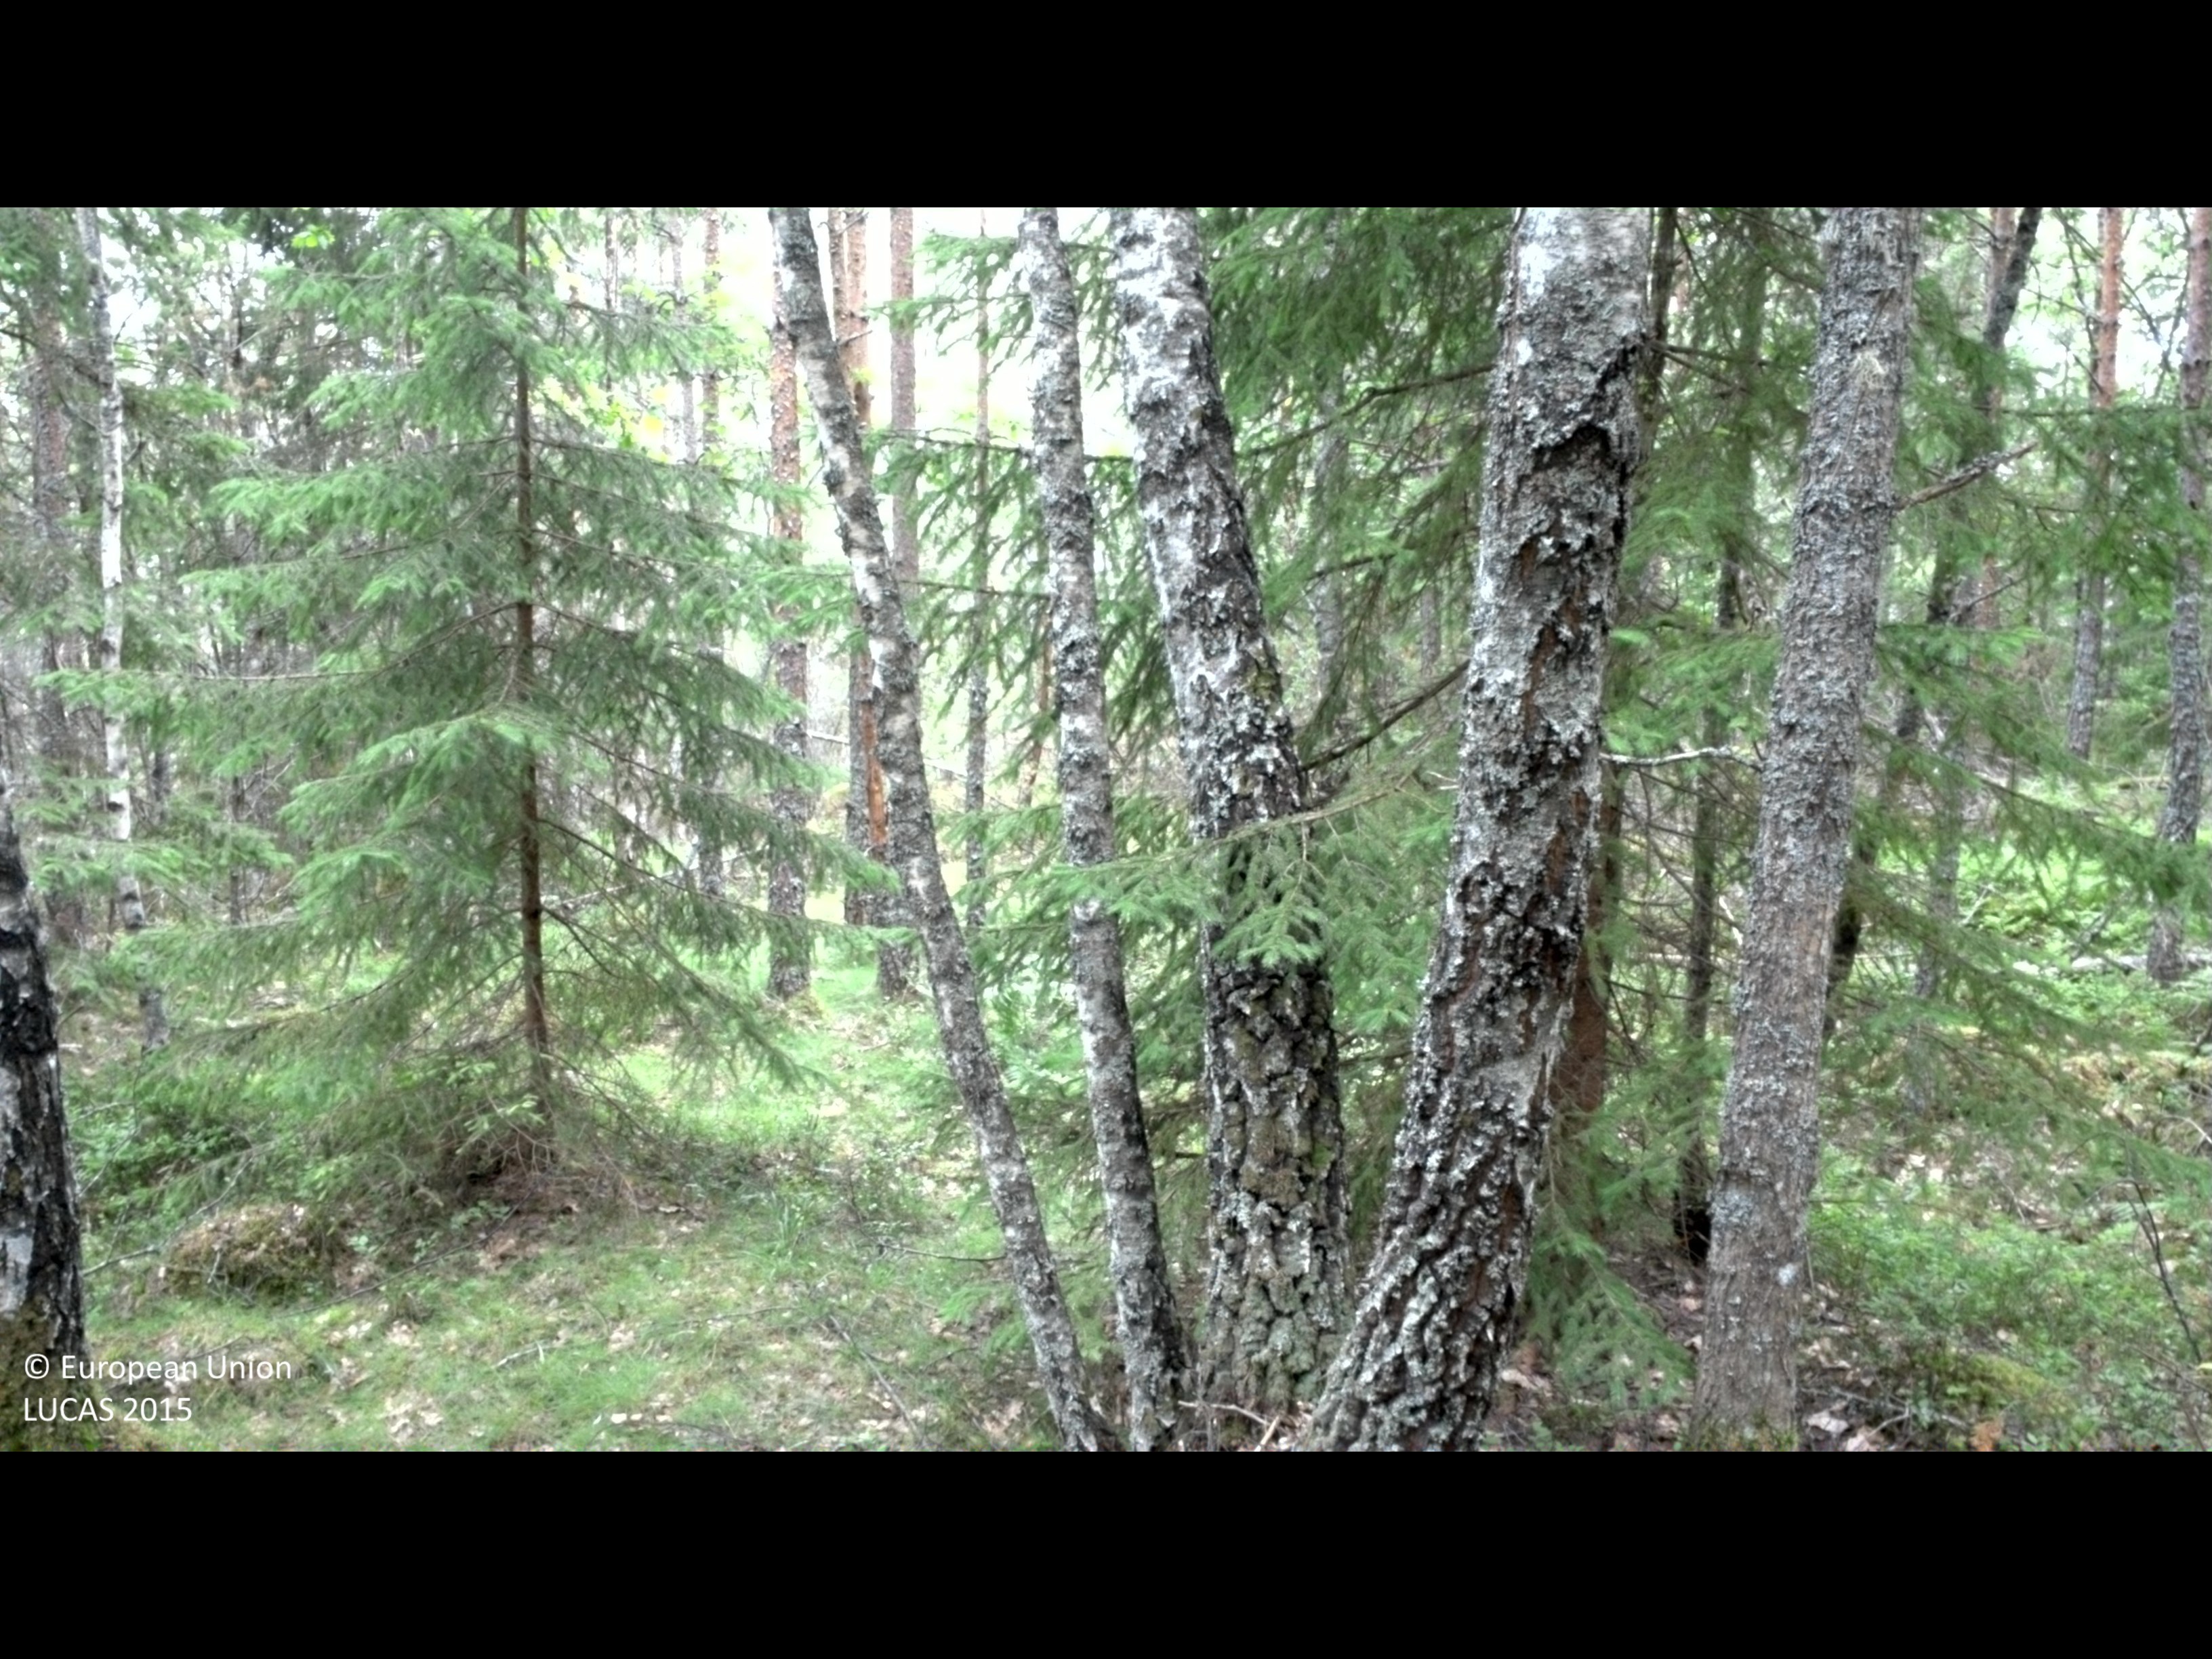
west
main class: Woodland
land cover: Pine dominated mixed woodland
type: boreal forest
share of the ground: > 75 %
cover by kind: coniferous forest trees 50 %, broadleaved forest trees 30 %, shrubs 10 %, herbaceous plants 5 %, lichens and mosses 5 %
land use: Forestry
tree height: > 5 m
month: June
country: SE
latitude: 58.1604
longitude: 16.3360
